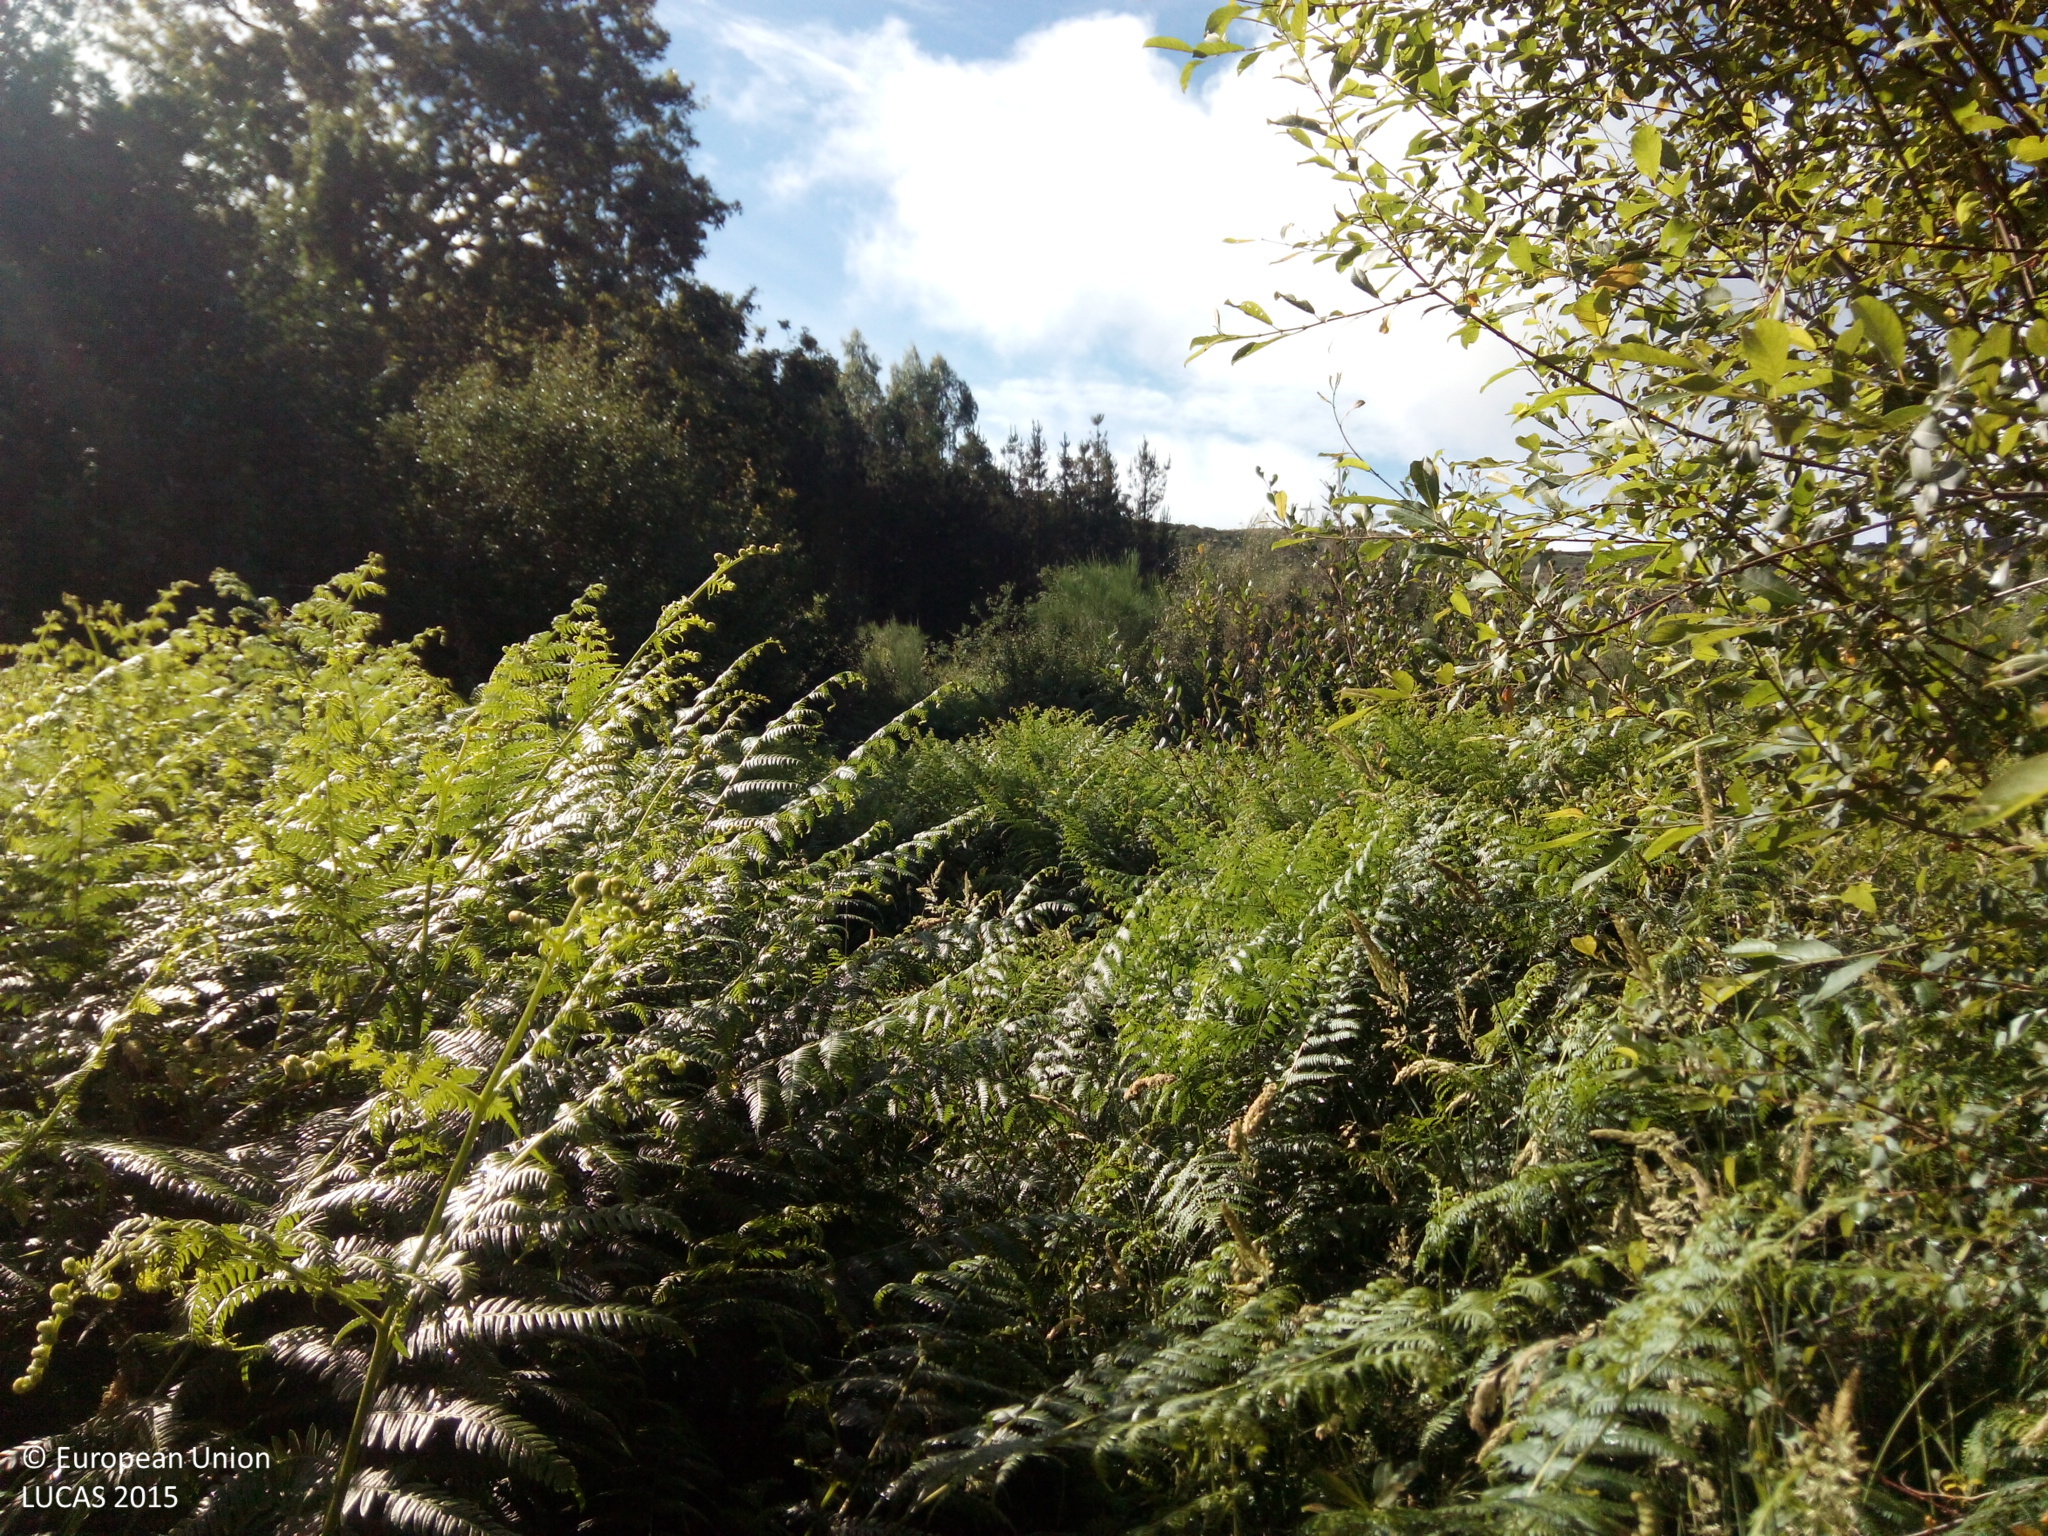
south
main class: Grassland
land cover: Grassland with sparse tree/shrub cover
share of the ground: > 75 %
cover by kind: herbaceous plants 95 %, coniferous forest trees 5 %
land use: Abandoned areas
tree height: < 5 m
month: July
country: ES
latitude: 42.3222
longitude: -8.2781
